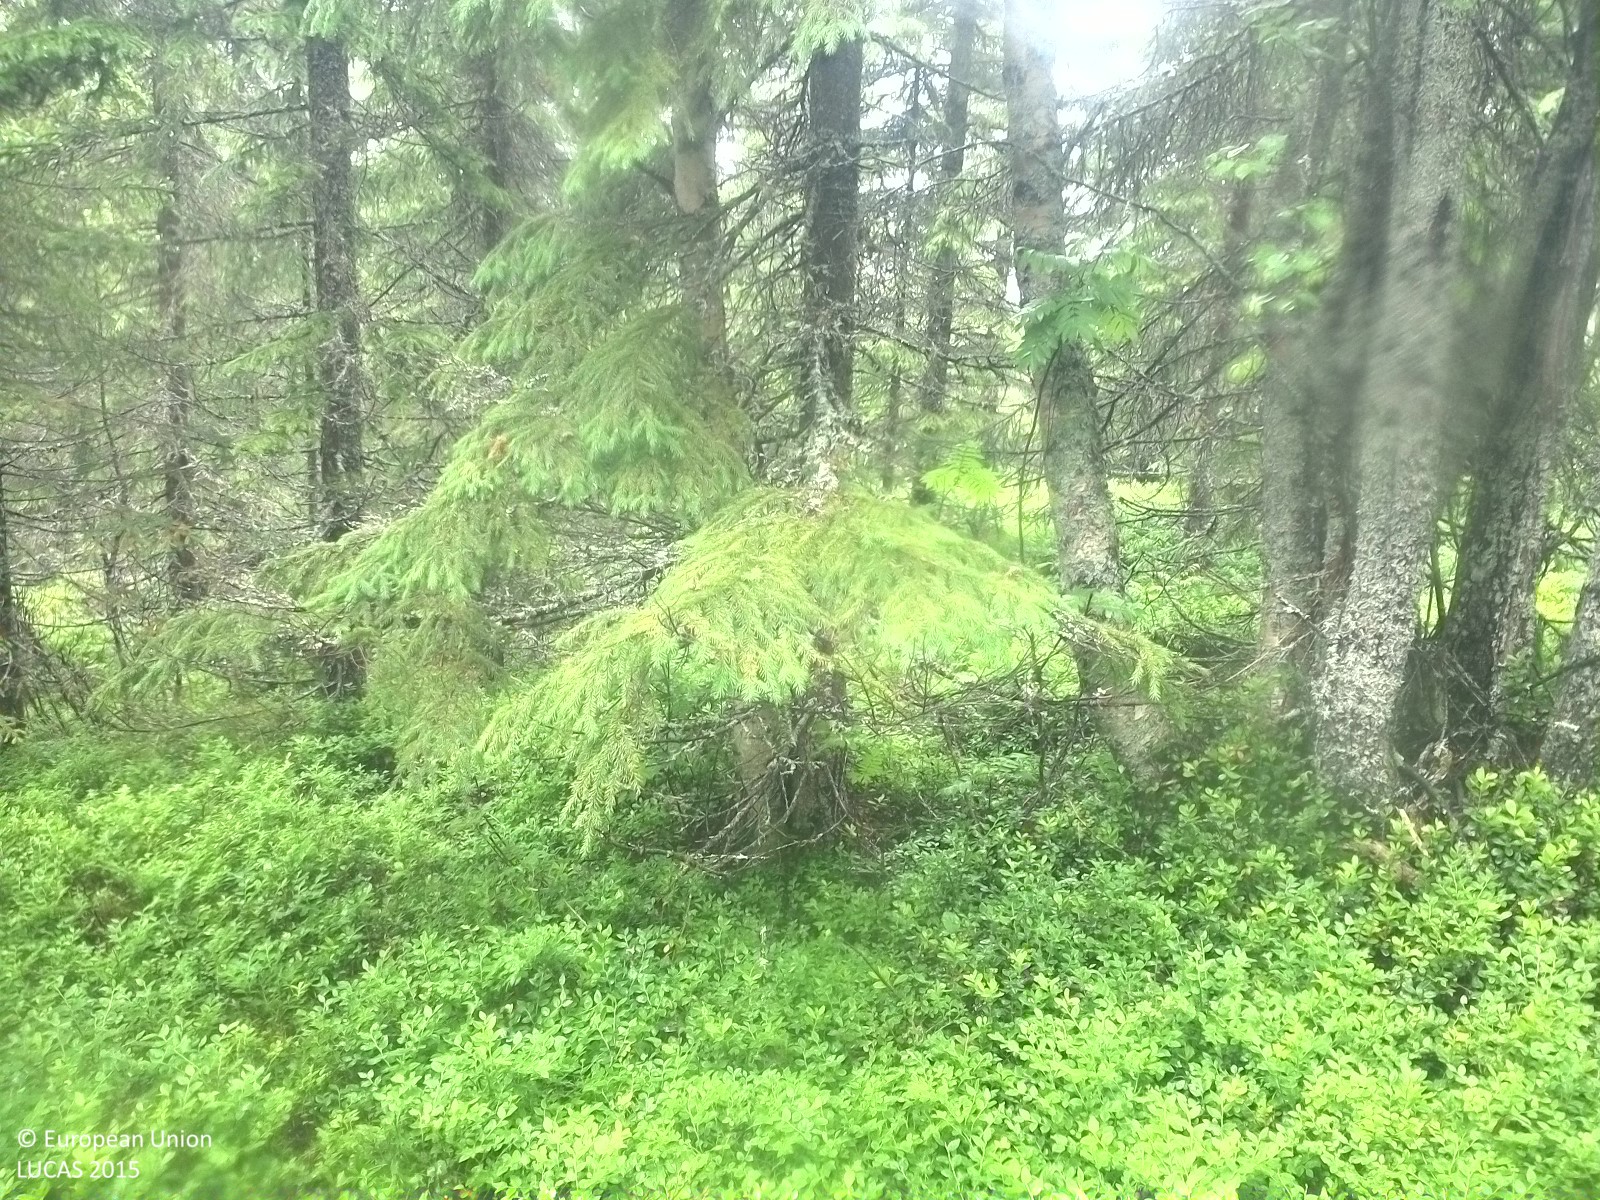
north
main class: Woodland
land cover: Spruce dominated mixed woodland
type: boreal forest
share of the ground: 25 - 50 %
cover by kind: shrubs 50 %, coniferous forest trees 35 %, broadleaved forest trees 15 %
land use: Forestry
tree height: > 5 m
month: July
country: SE
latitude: 62.4721
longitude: 16.9033
